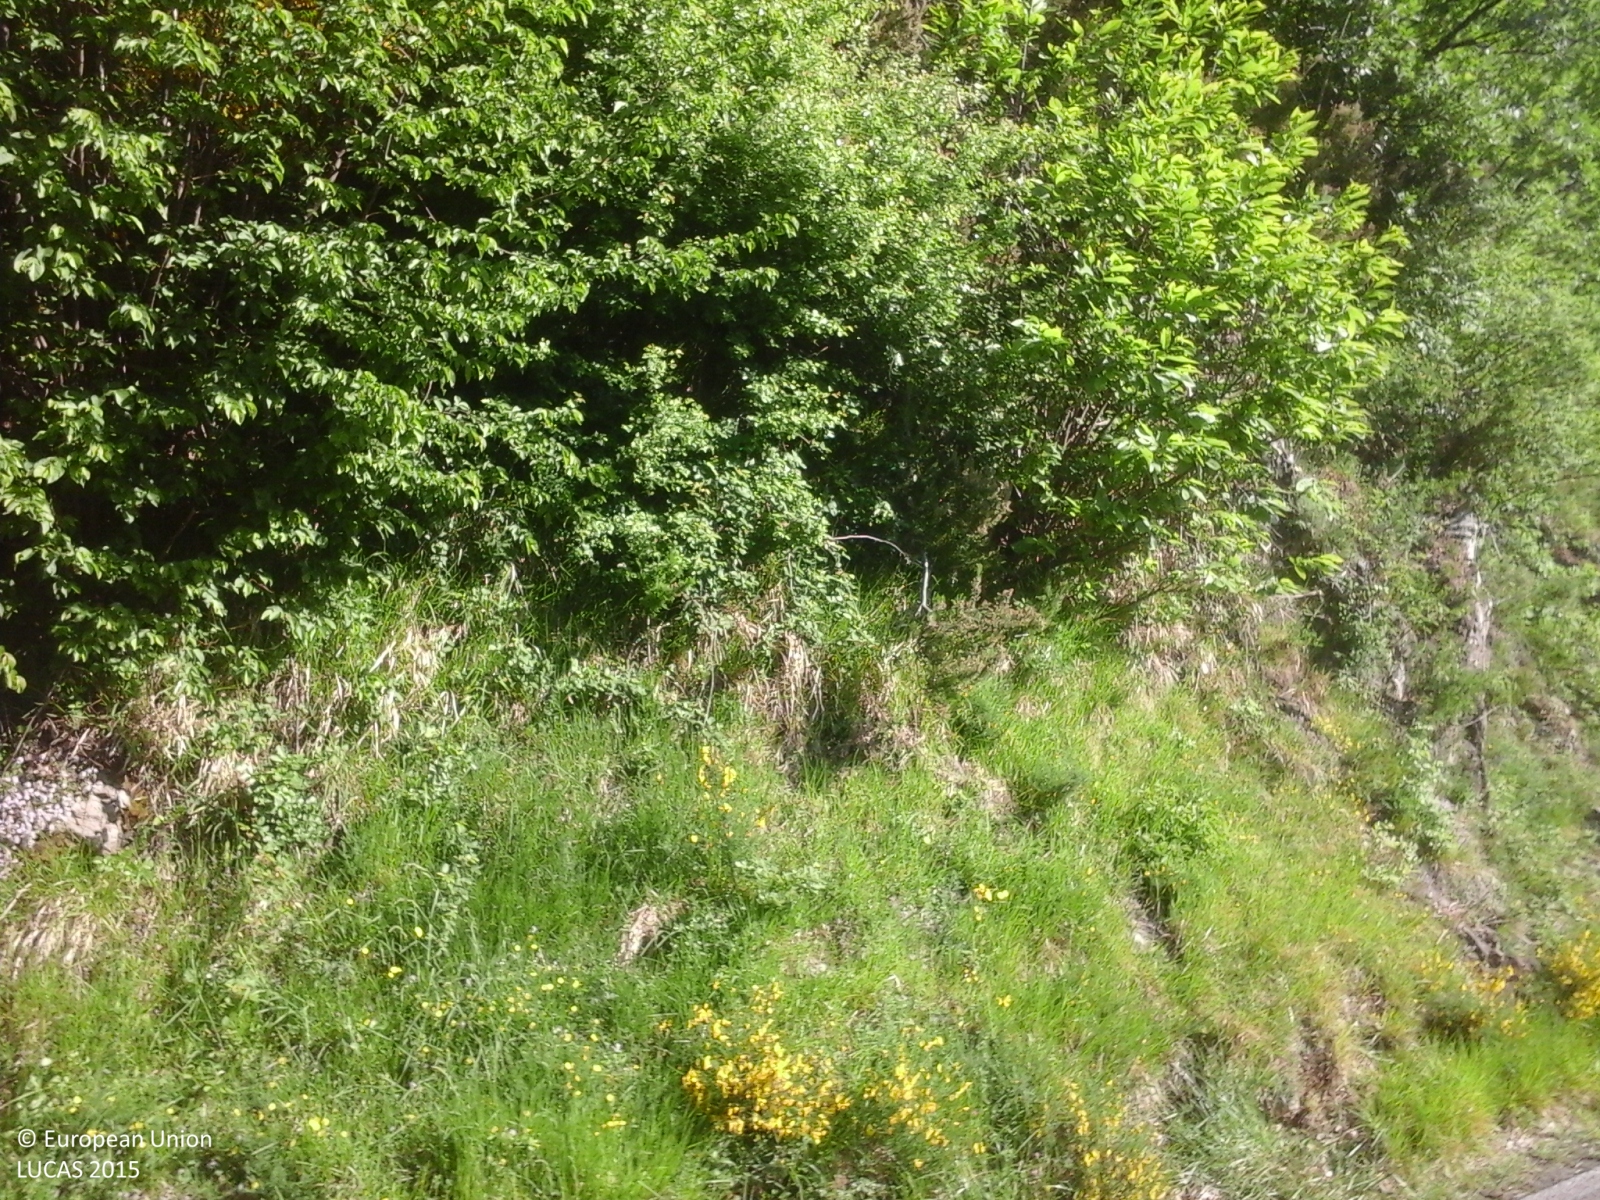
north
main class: Woodland
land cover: Broadleaved woodland
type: thermophilous deciduous forest
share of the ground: > 75 %
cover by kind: broadleaved forest trees 100 %
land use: Forestry
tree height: > 5 m
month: May
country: IT
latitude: 44.1116
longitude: 10.9597
